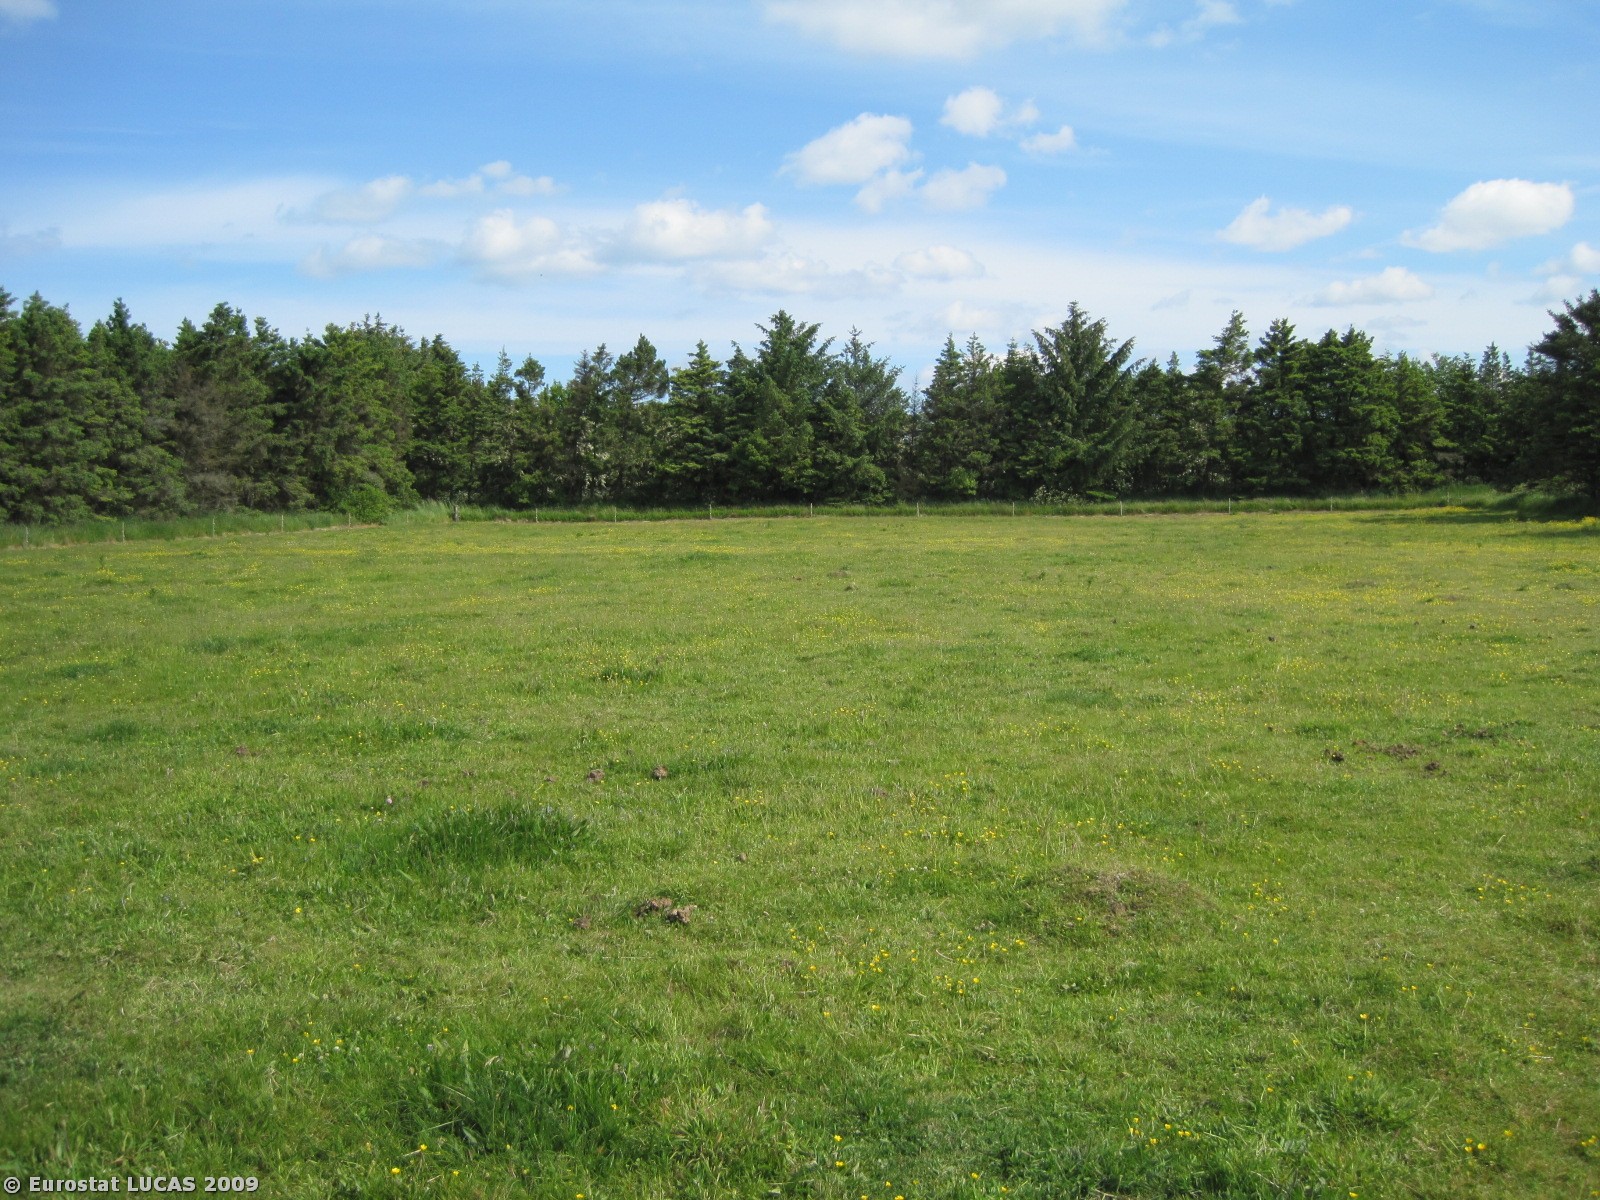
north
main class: Grassland
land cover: Grassland without tree/shrub cover
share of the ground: > 75 %
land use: Agriculture (excluding fallow land and kitchen gardens)
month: June
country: DK
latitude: 57.4280
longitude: 9.7839
